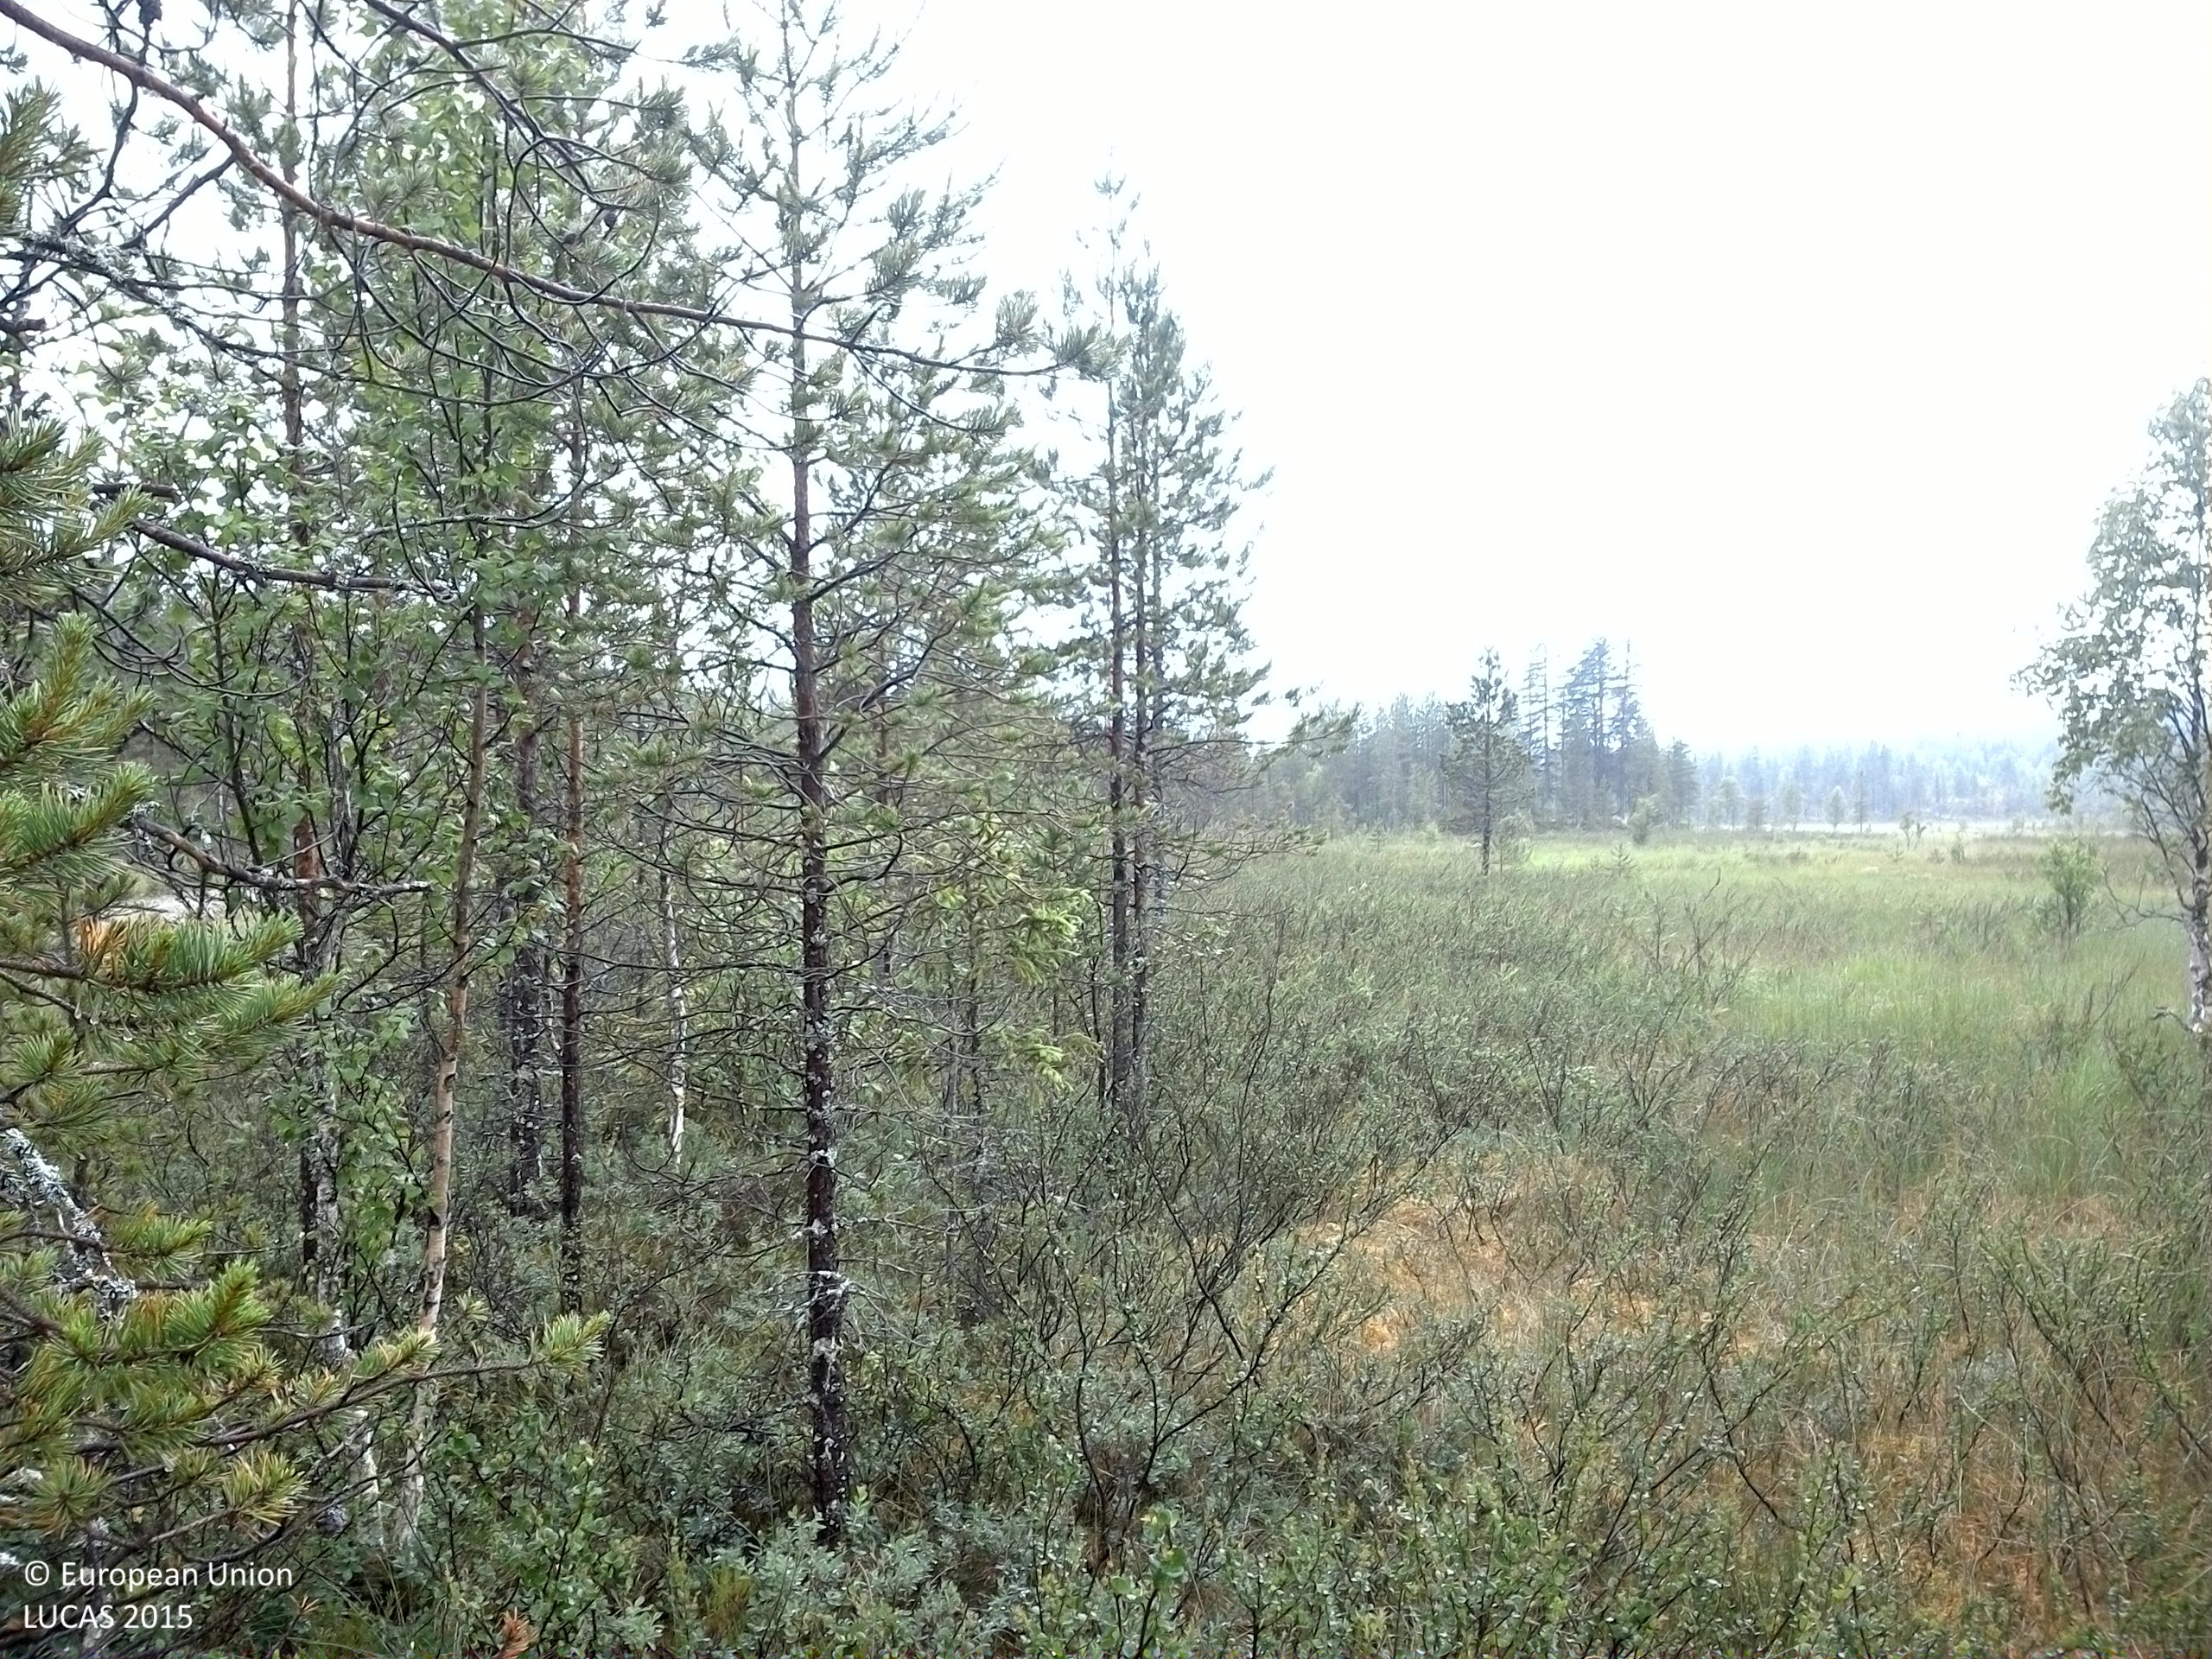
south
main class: Woodland
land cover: Pine dominated mixed woodland
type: boreal forest
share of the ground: 25 - 50 %
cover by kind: shrubs 40 %, lichens and mosses 20 %, coniferous forest trees 15 %, broadleaved forest trees 15 %, herbaceous plants 10 %
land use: Semi-natural and natural areas not in use
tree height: < 5 m
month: July
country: SE
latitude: 63.6656
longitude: 17.3475
